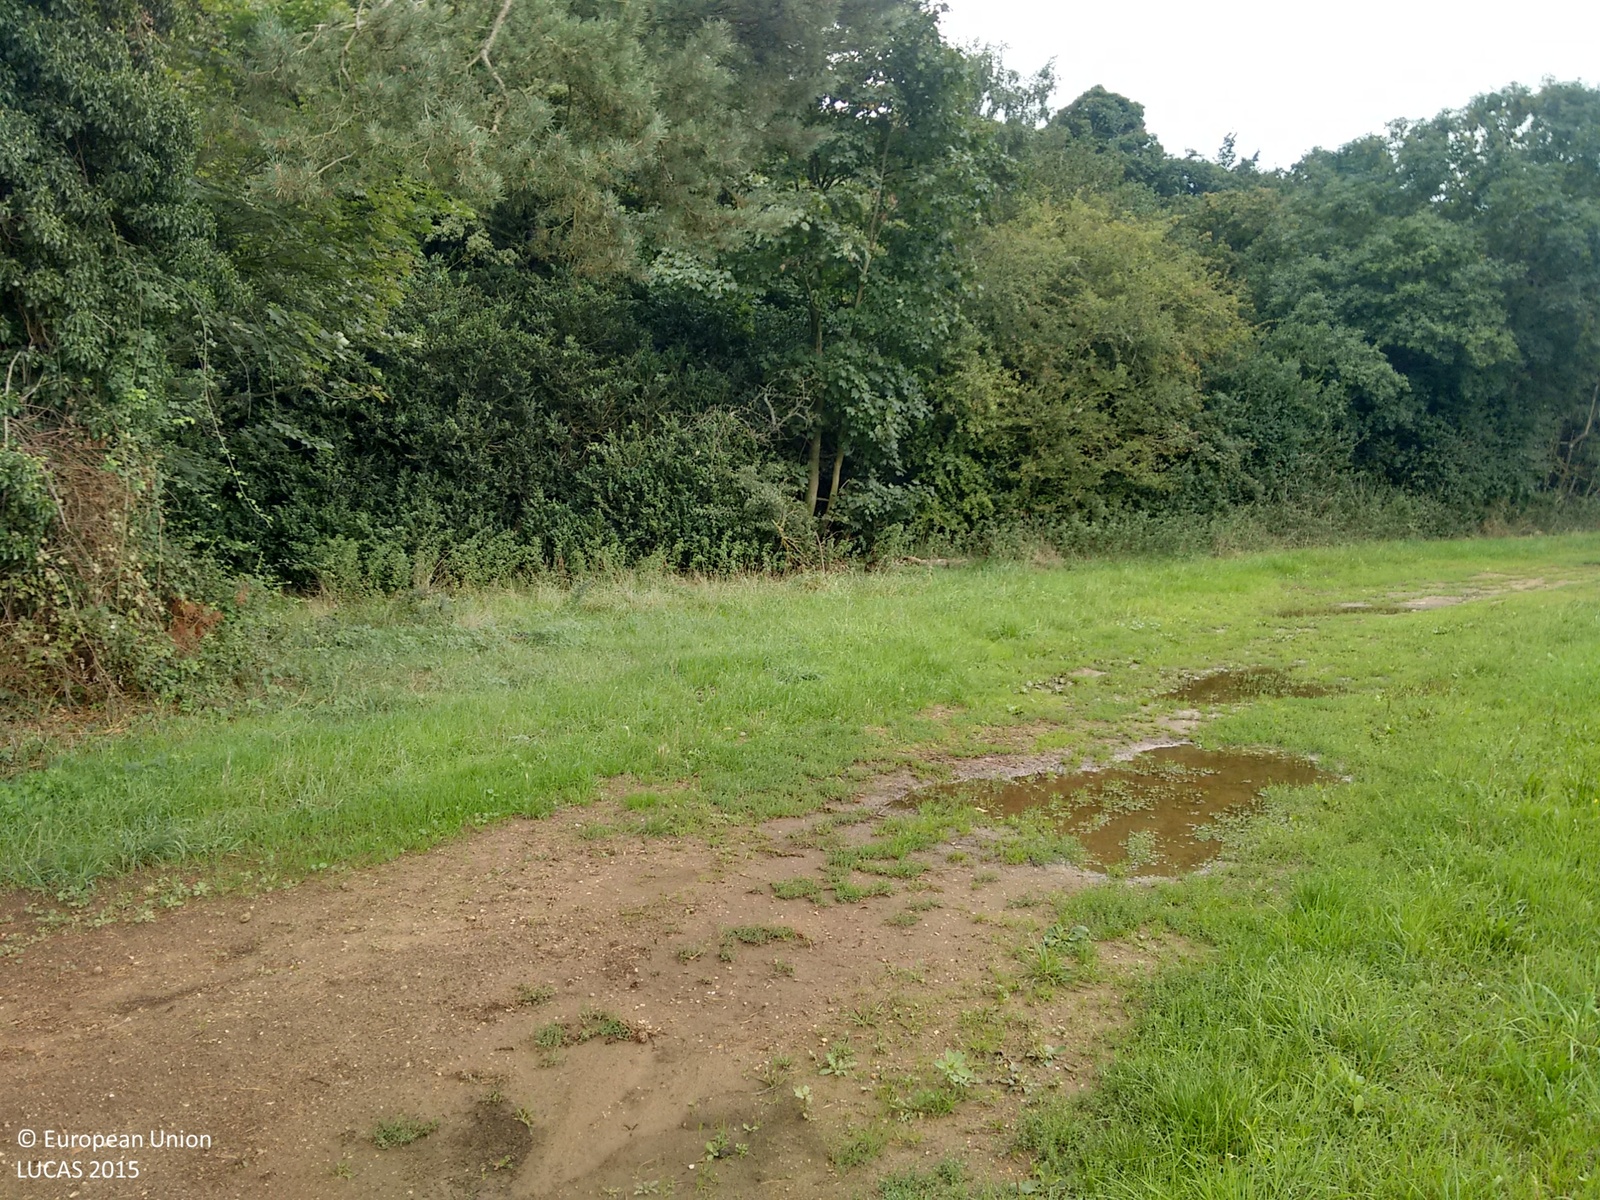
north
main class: Grassland
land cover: Grassland without tree/shrub cover
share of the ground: > 75 %
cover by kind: herbaceous plants 100 %
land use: Agriculture (excluding fallow land and kitchen gardens)
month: September
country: GB
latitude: 52.2999
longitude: 0.4549
